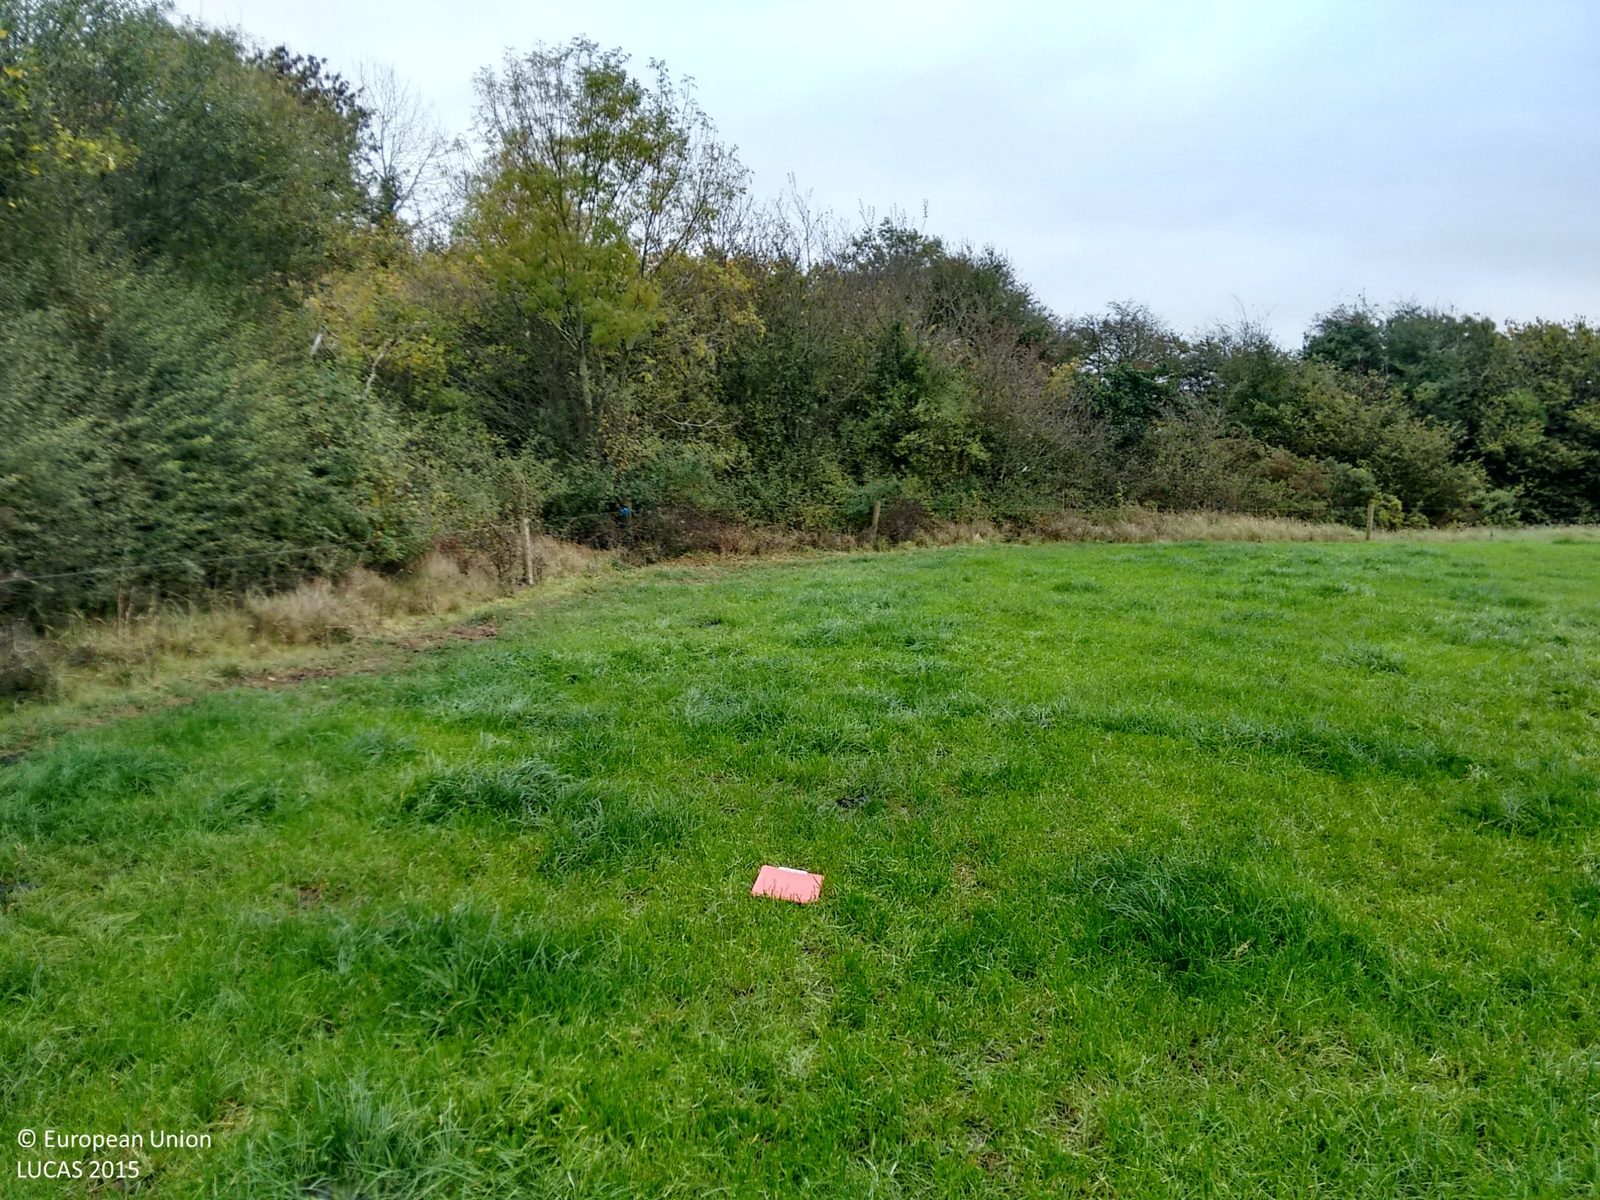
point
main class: Grassland
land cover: Grassland without tree/shrub cover
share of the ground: > 75 %
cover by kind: herbaceous plants 95 %, unconsolidated bare surface 5 %
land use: Agriculture (excluding fallow land and kitchen gardens)
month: October
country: IE
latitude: 52.7344
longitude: -7.7770
